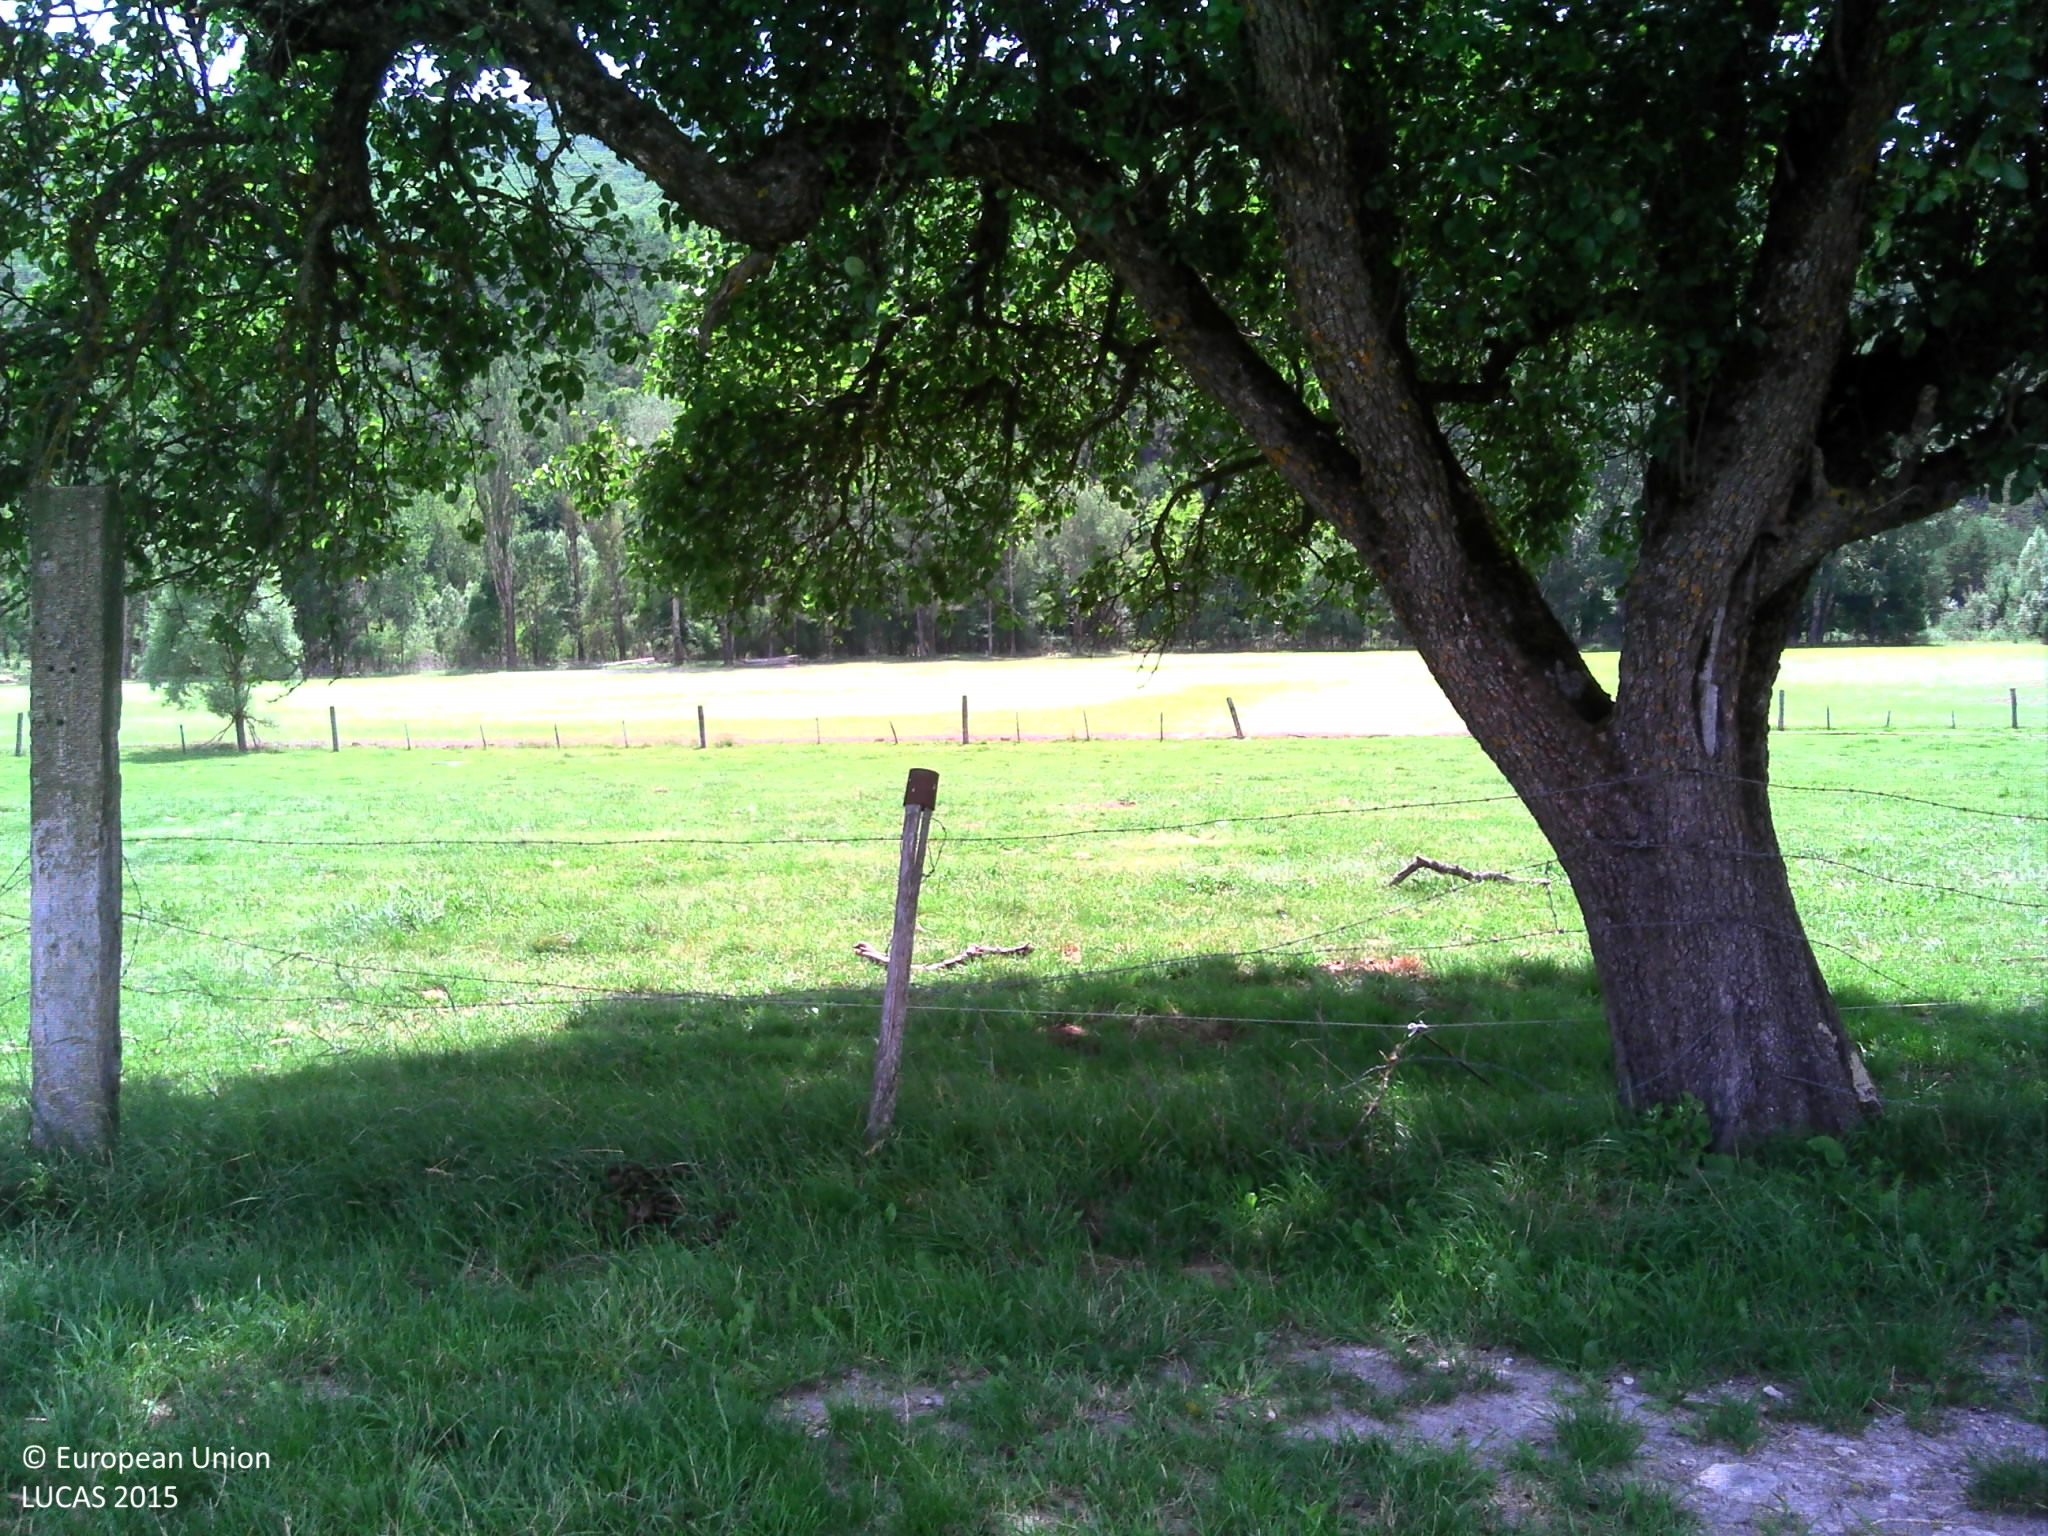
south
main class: Cropland
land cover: Mixed cereals for fodder
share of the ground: > 75 %
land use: Agriculture (excluding fallow land and kitchen gardens)
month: June
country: FR
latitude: 44.2196
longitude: 5.5641
